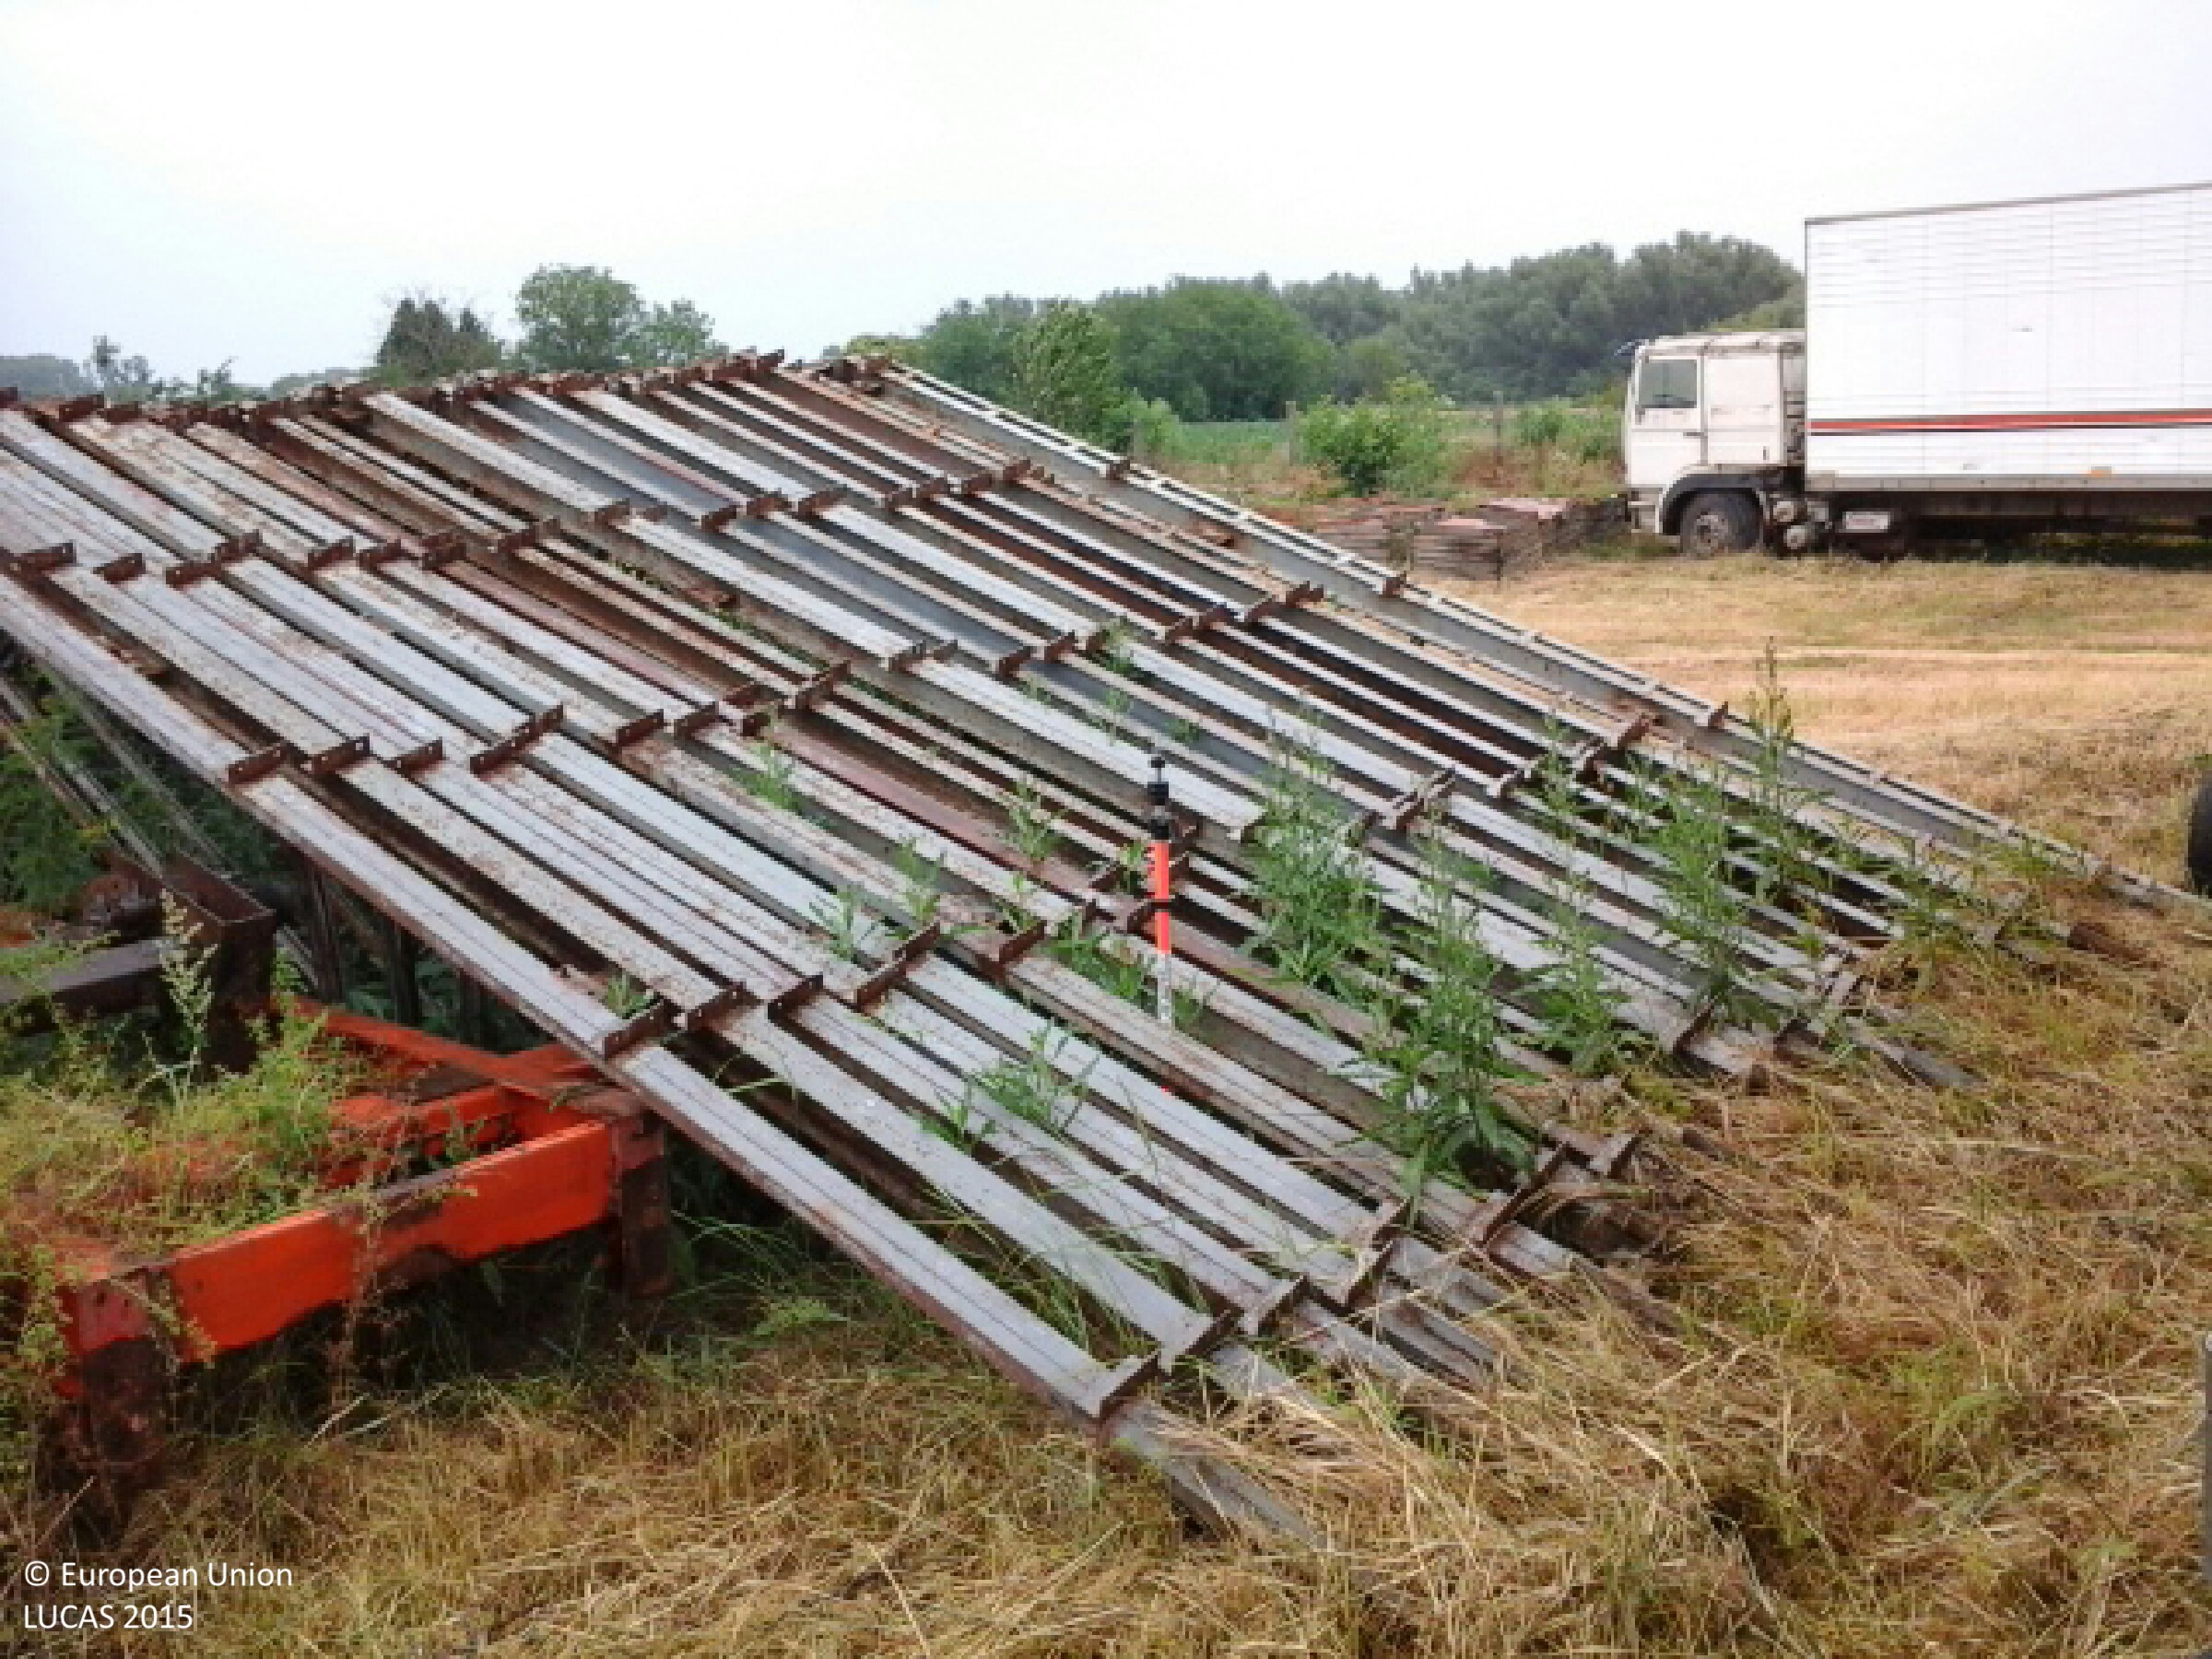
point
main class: Grassland
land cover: Spontaneously vegetated surfaces
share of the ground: > 75 %
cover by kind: herbaceous plants 90 %, unconsolidated bare surface 10 %
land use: Abandoned areas
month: June
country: HU
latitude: 47.9753
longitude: 21.7432
